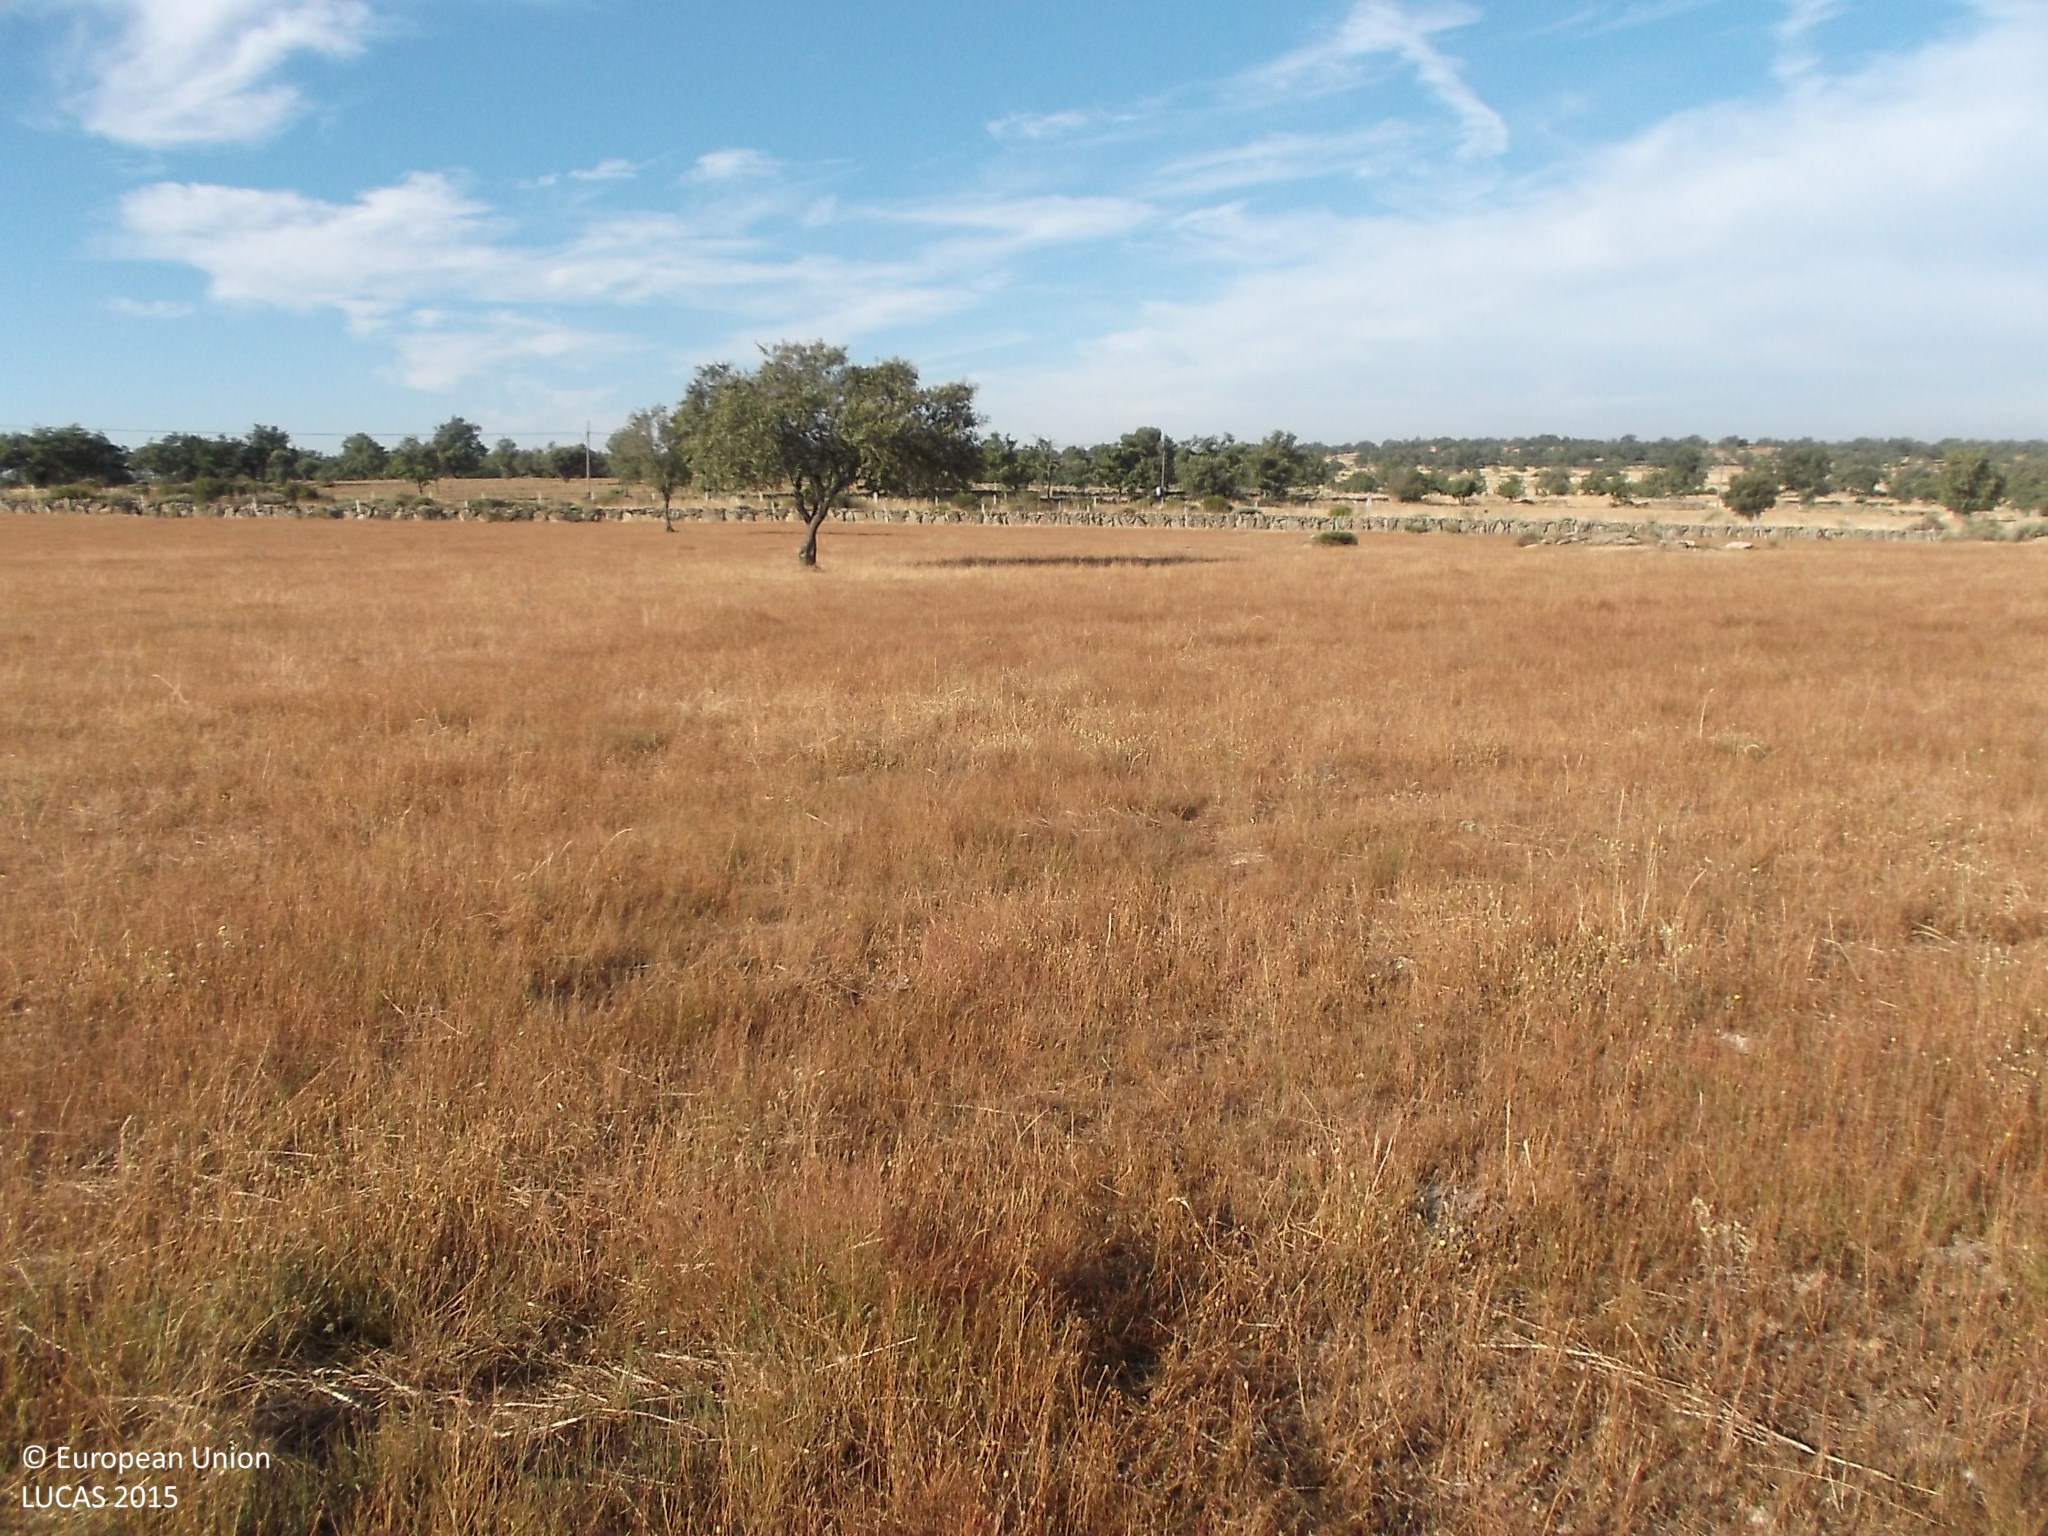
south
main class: Grassland
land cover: Grassland without tree/shrub cover
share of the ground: > 75 %
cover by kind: herbaceous plants 100 %
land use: Agriculture (excluding fallow land and kitchen gardens)
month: July
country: ES
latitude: 41.2261
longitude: -6.3308
